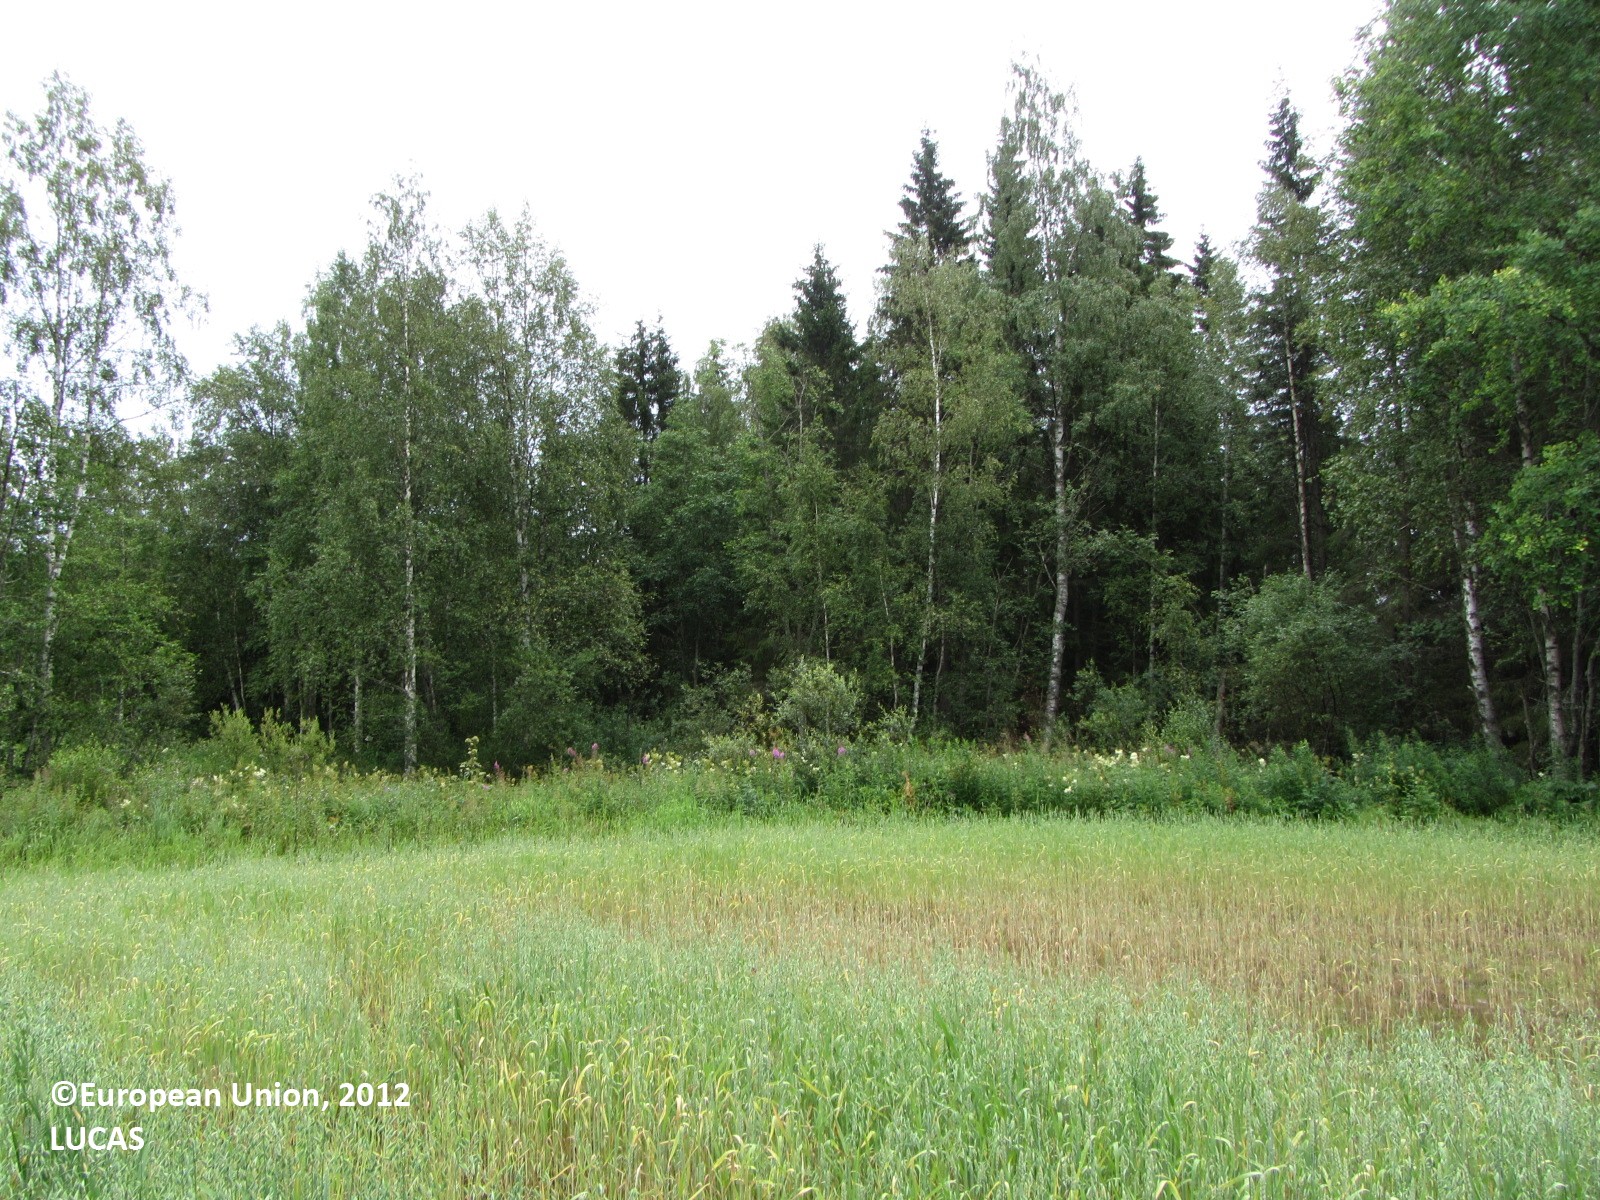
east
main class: Cropland
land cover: Mixed cereals for fodder
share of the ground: > 75 %
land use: Agriculture (excluding fallow land and kitchen gardens)
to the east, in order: Mixed cereals for fodder; Spontaneously vegetated surfaces; Inland running water; Spruce dominated mixed woodland; Broadleaved woodland
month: August
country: FI
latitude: 63.4452
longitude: 25.3153
